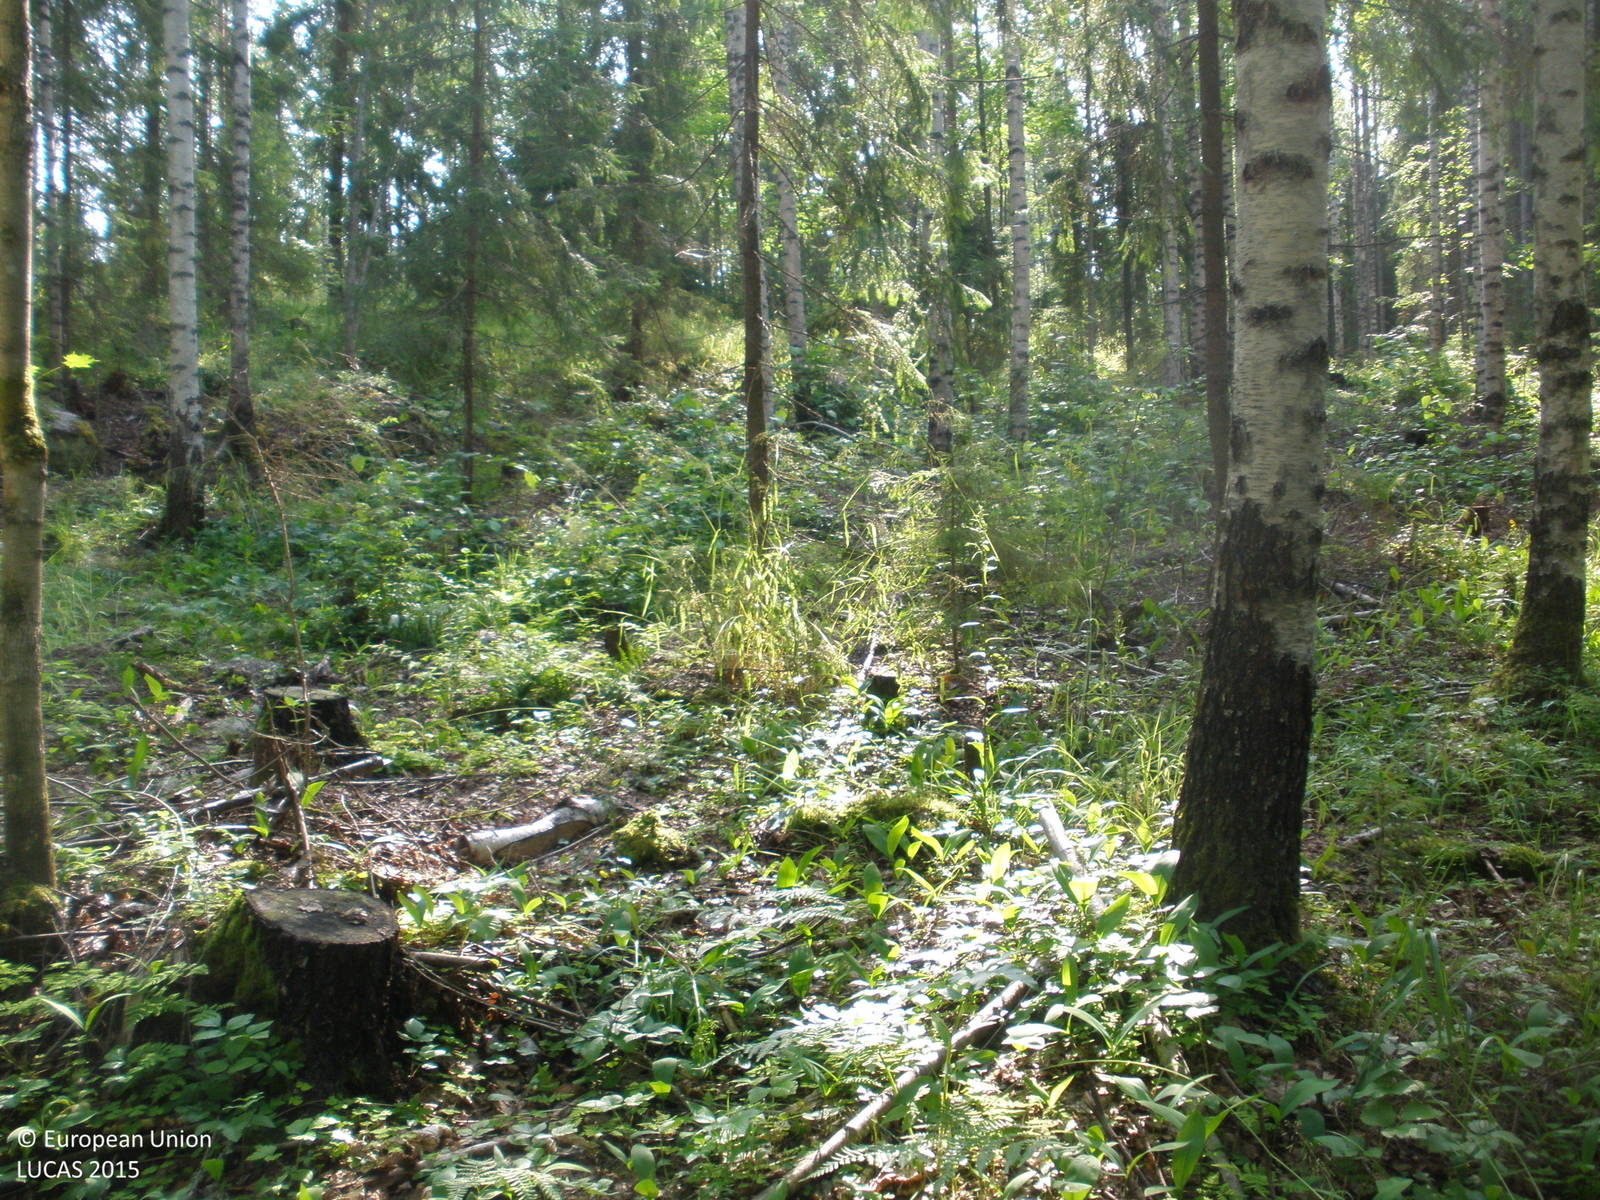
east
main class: Woodland
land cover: Spruce dominated mixed woodland
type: boreal forest
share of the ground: > 75 %
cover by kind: broadleaved forest trees 55 %, coniferous forest trees 30 %, herbaceous plants 10 %, shrubs 5 %
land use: Forestry
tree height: > 5 m
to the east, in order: Spruce dominated mixed woodland; Tracks; Spruce dominated mixed woodland; Spruce dominated coniferous woodland
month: July
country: FI
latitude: 61.4379
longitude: 23.8291
